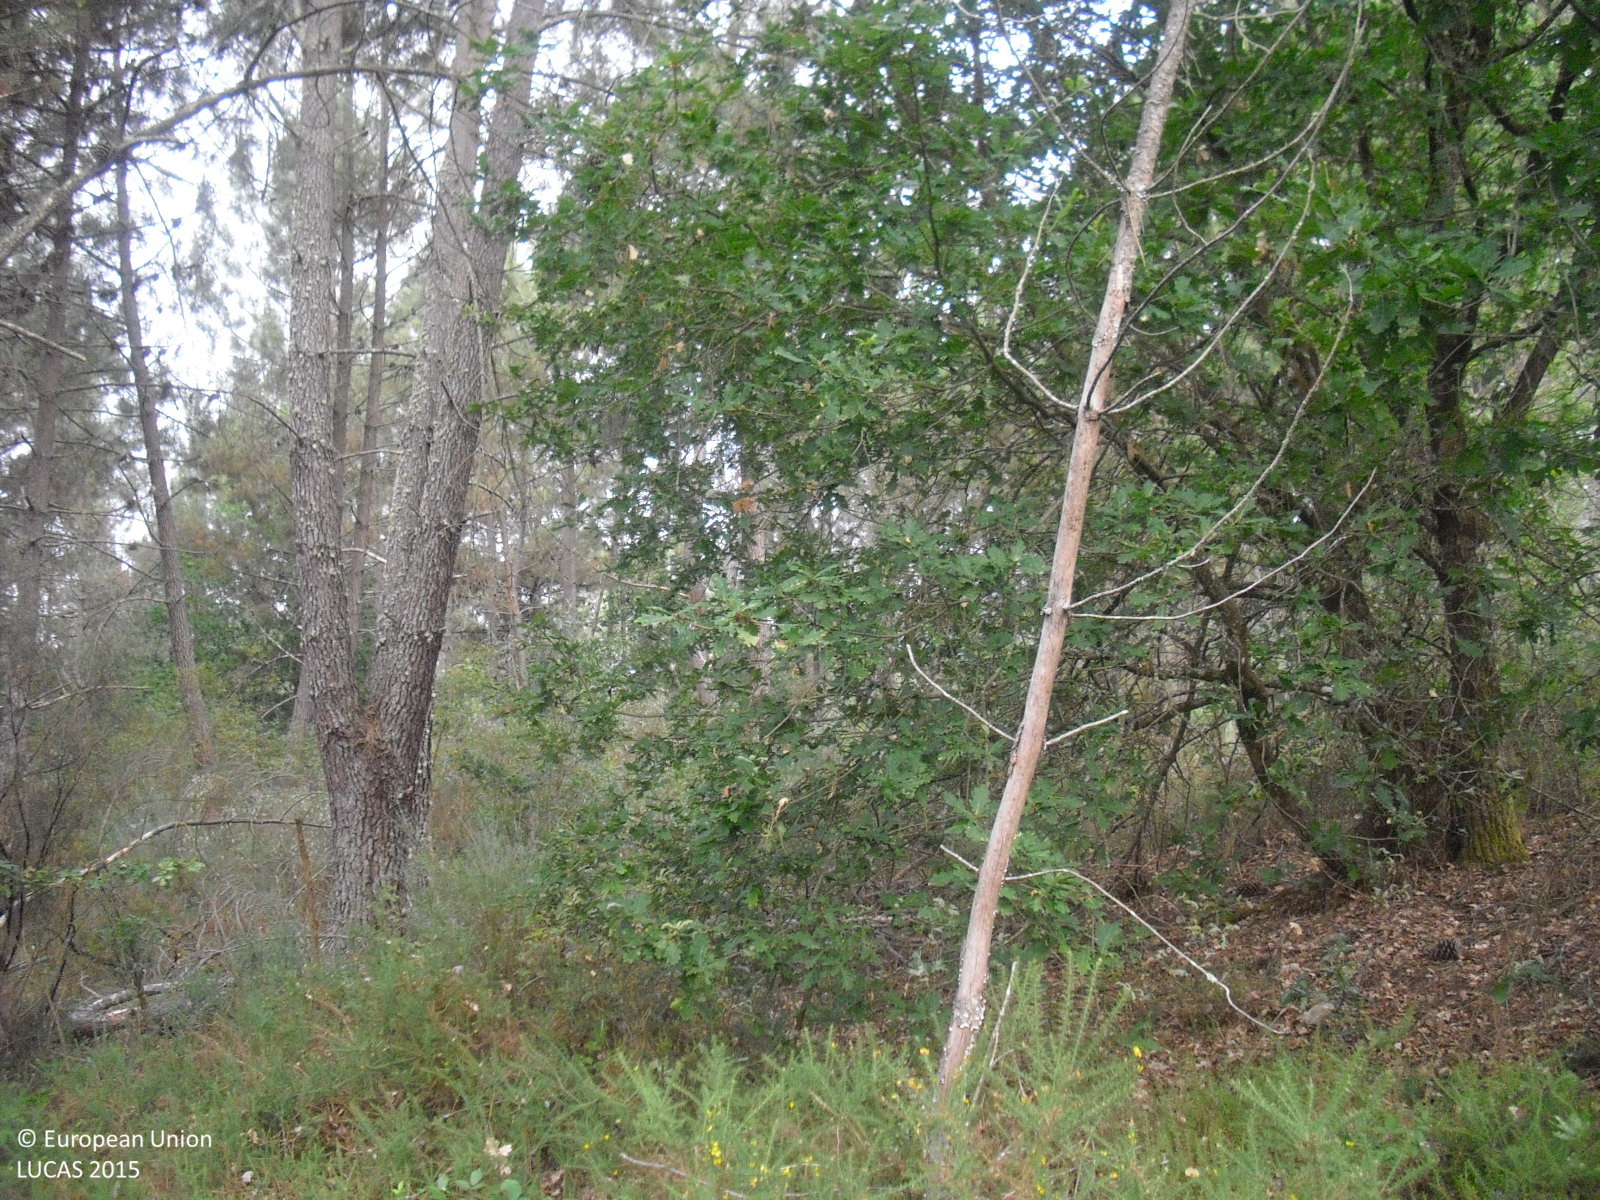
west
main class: Woodland
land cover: Pine dominated mixed woodland
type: hemiboreal forest and nemoral coniferous forest and mixed broadleaved-coniferous forest
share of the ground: > 75 %
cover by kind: shrubs 60 %, coniferous forest trees 30 %, broadleaved forest trees 10 %
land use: Forestry
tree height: > 5 m
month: July
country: ES
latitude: 42.5455
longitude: -7.4453
